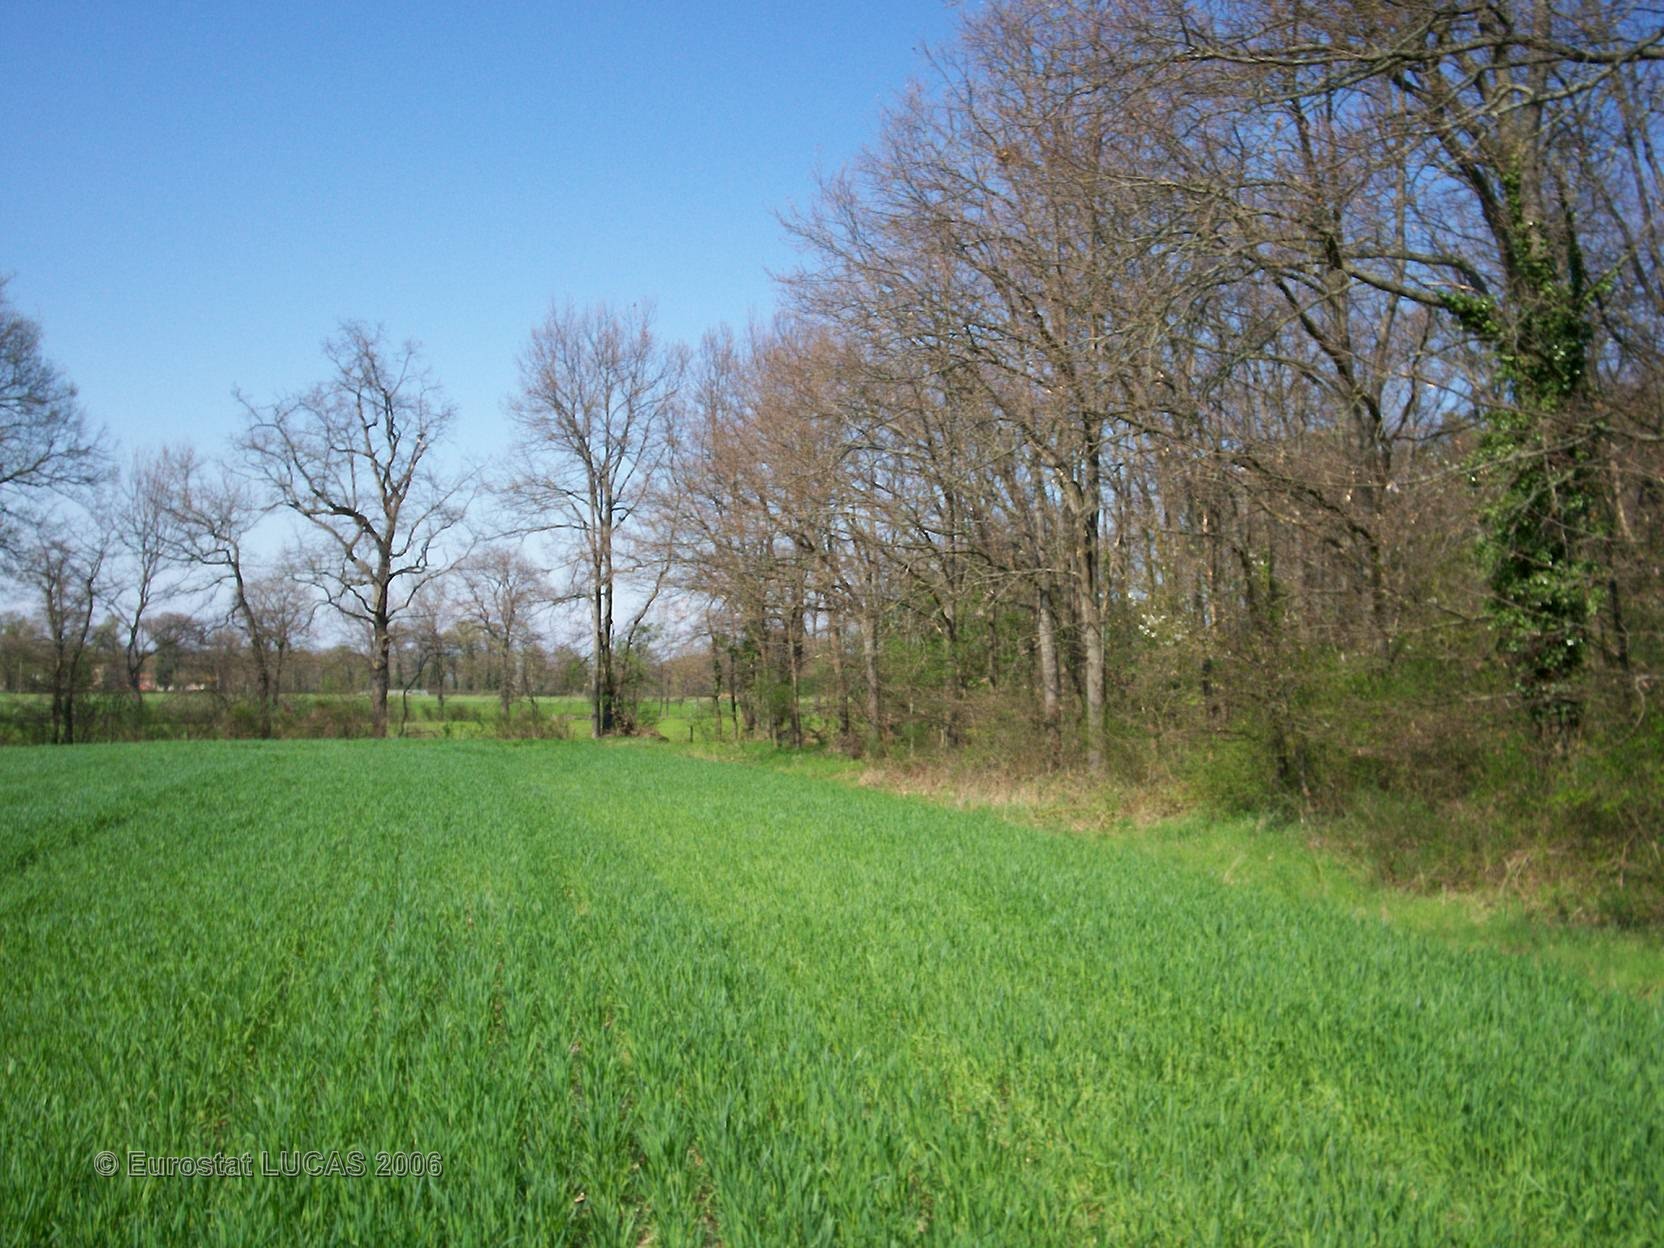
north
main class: Cropland
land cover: Common wheat
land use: Agriculture (excluding fallow land and kitchen gardens)
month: April
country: FR
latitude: 45.6666
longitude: 4.1369
